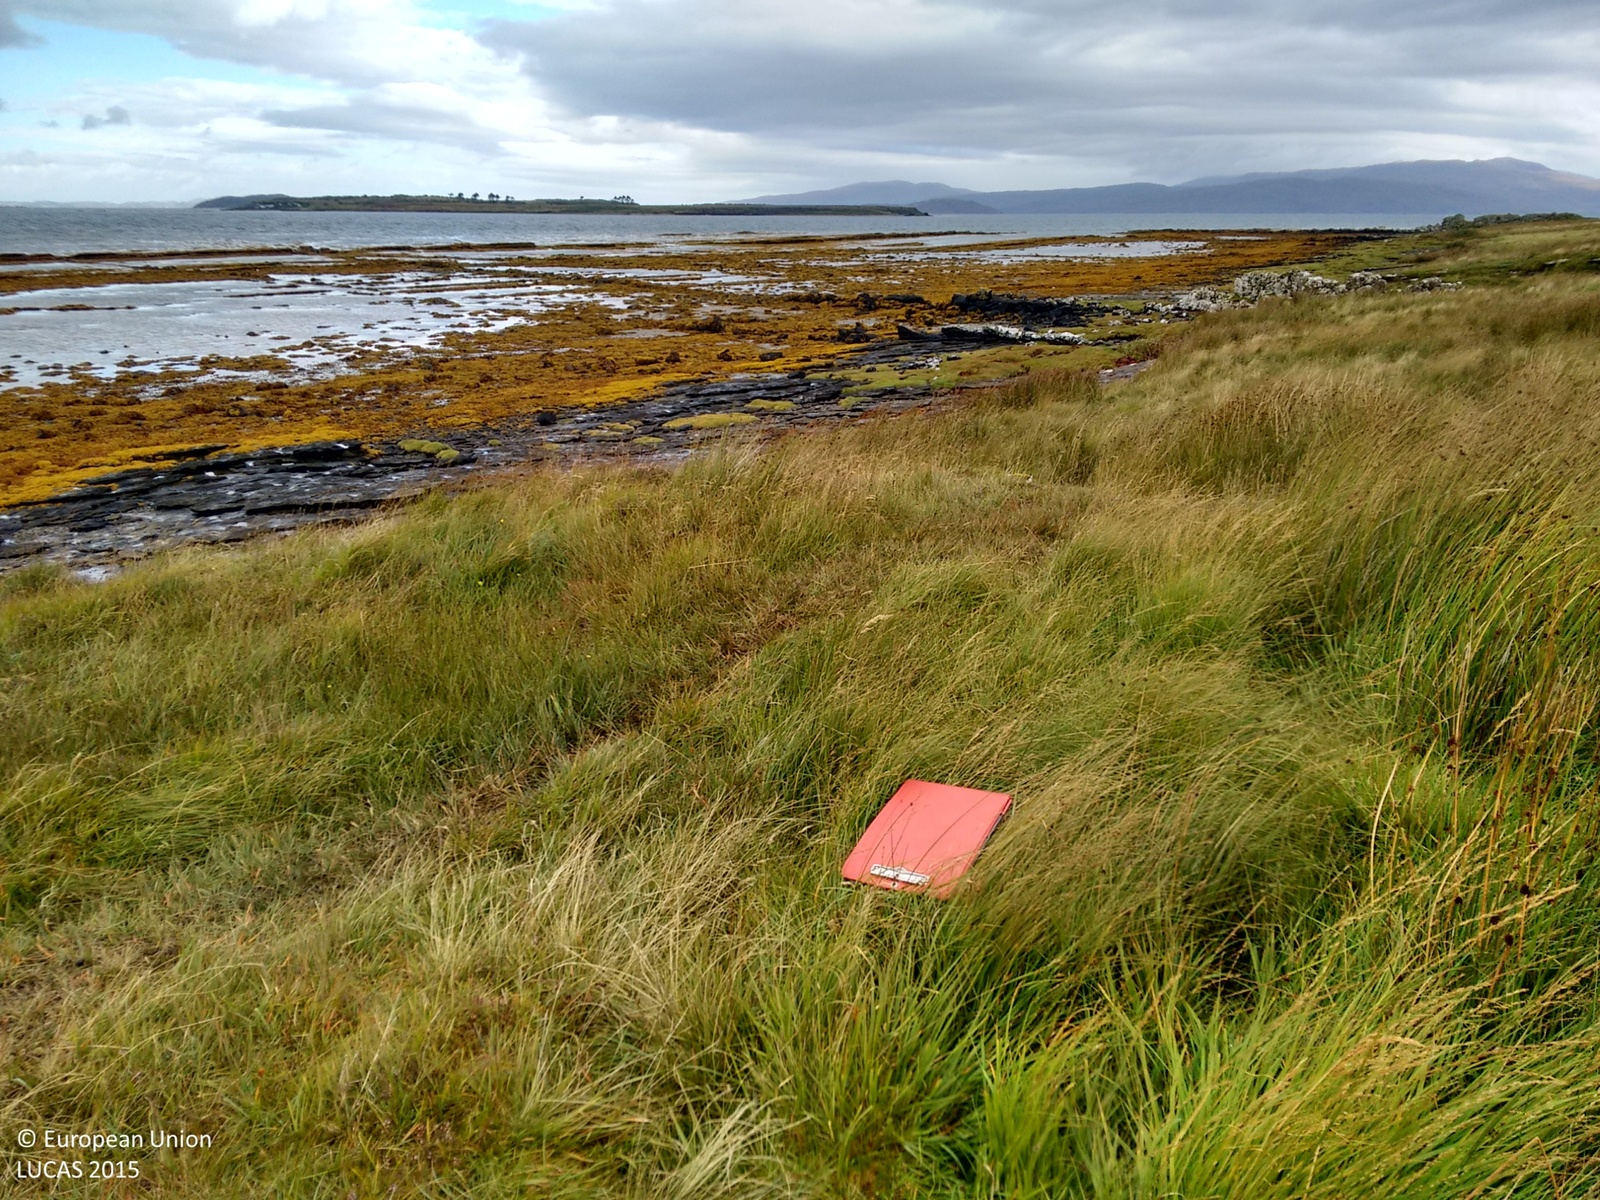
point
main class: Grassland
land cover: Grassland without tree/shrub cover
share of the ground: > 75 %
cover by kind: herbaceous plants 95 %, shrubs 5 %
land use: Agriculture (excluding fallow land and kitchen gardens)
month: September
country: GB
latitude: 57.2507
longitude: -5.8548
